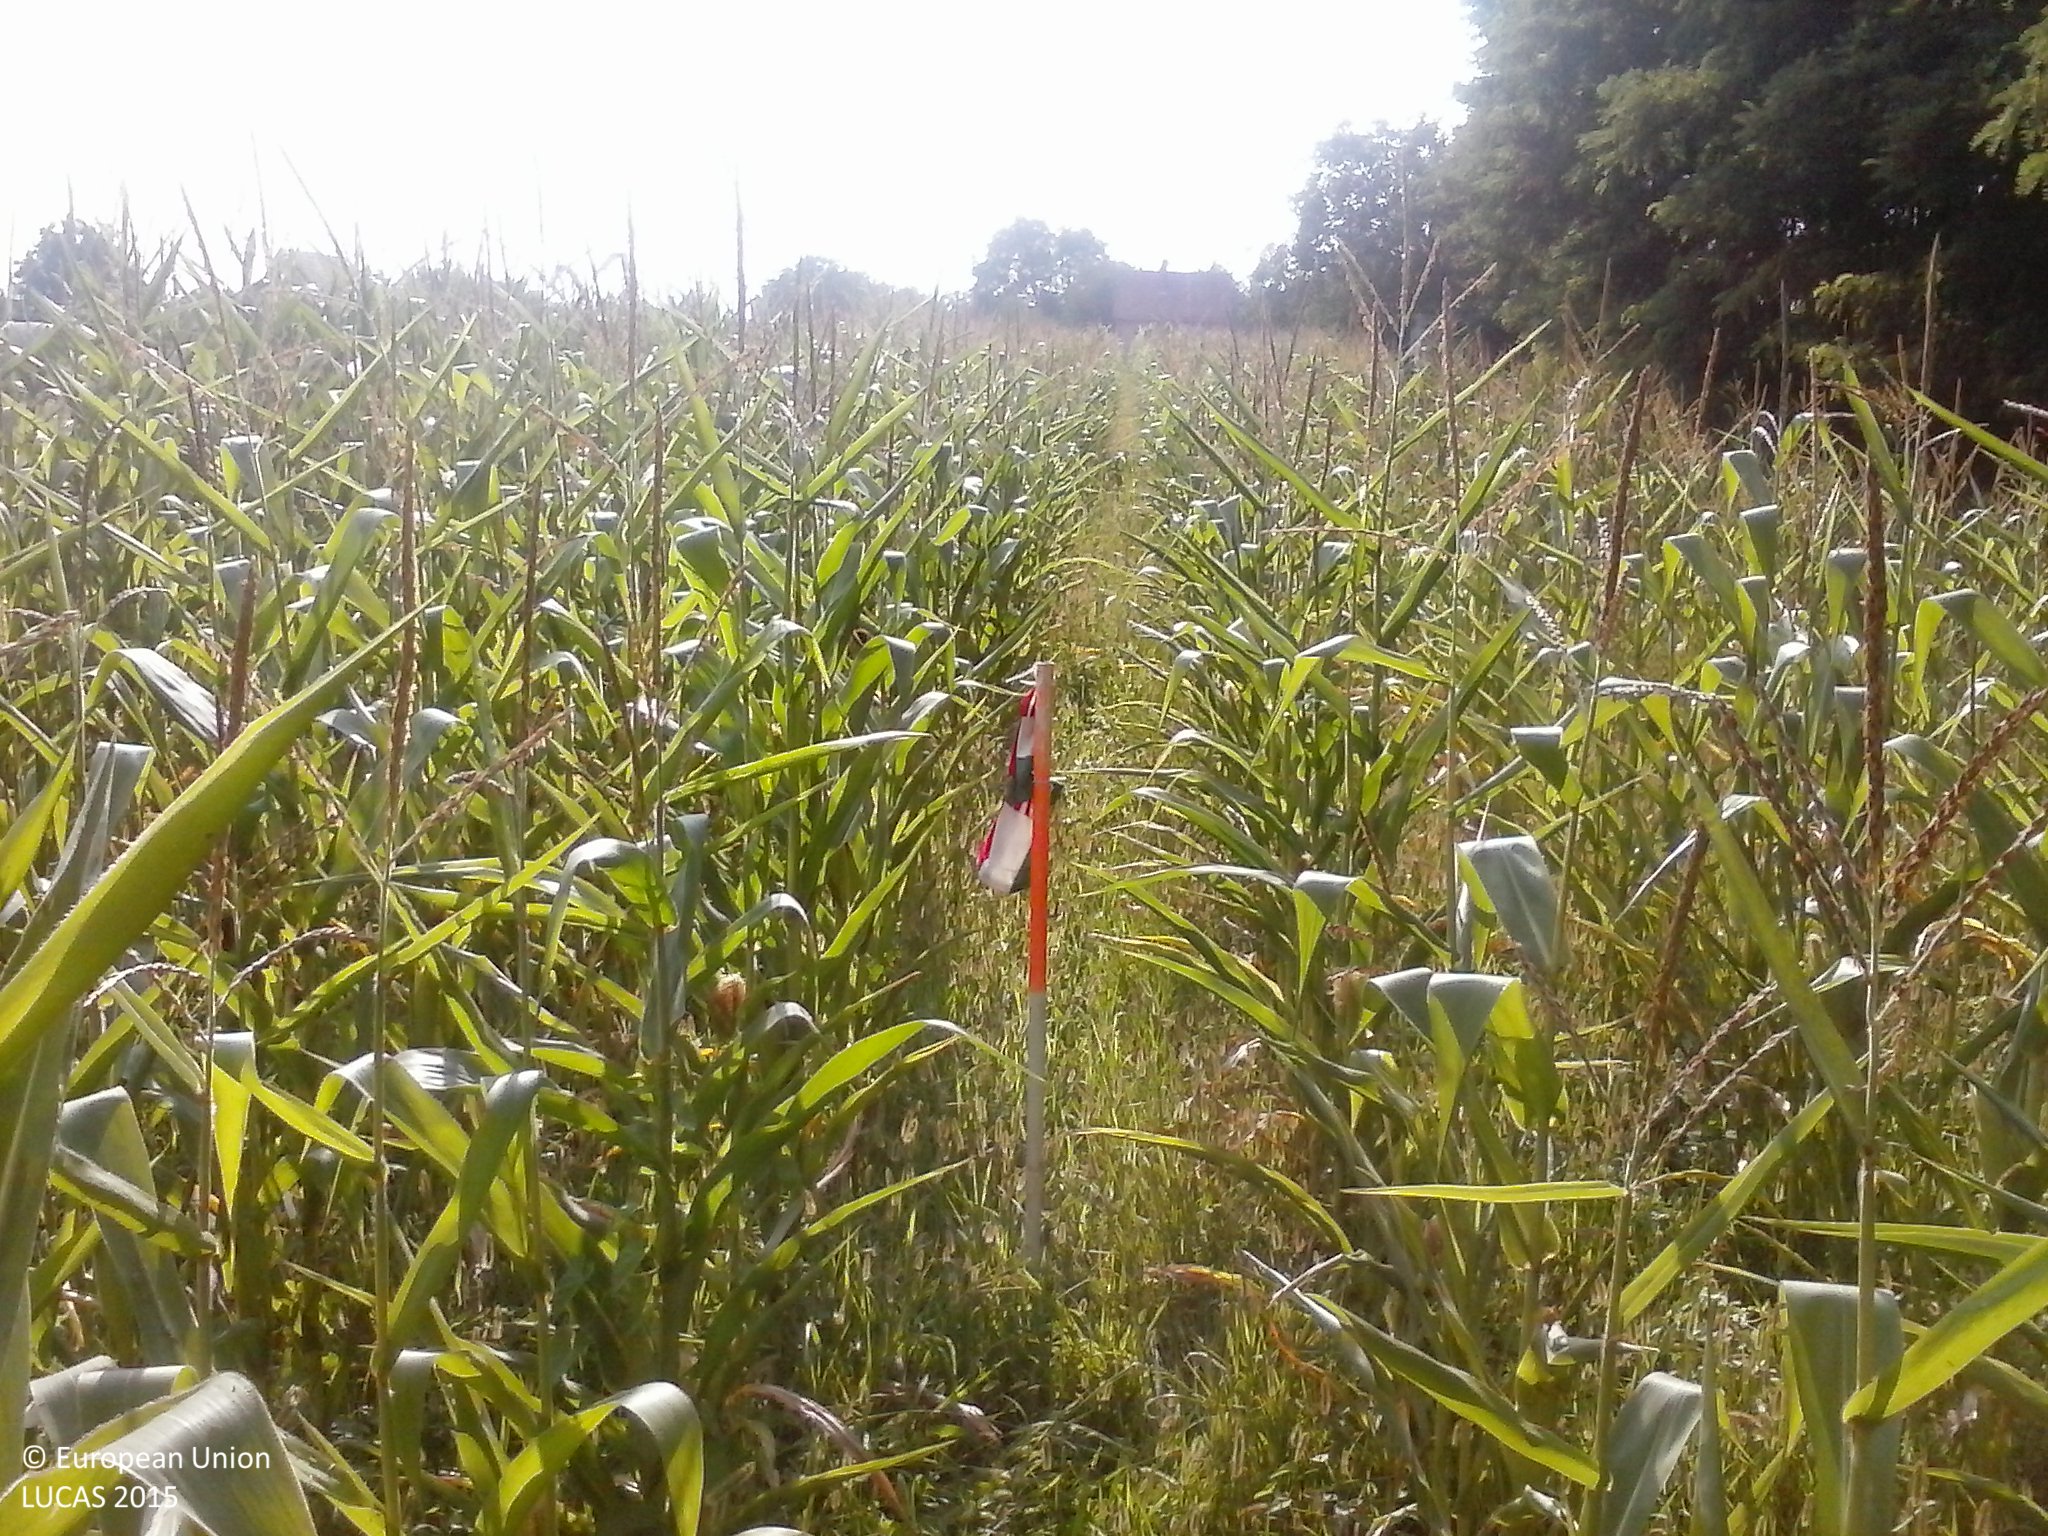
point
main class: Cropland
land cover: Maize
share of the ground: > 75 %
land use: Agriculture (excluding fallow land and kitchen gardens)
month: August
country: HU
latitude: 46.0859
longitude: 17.7772
